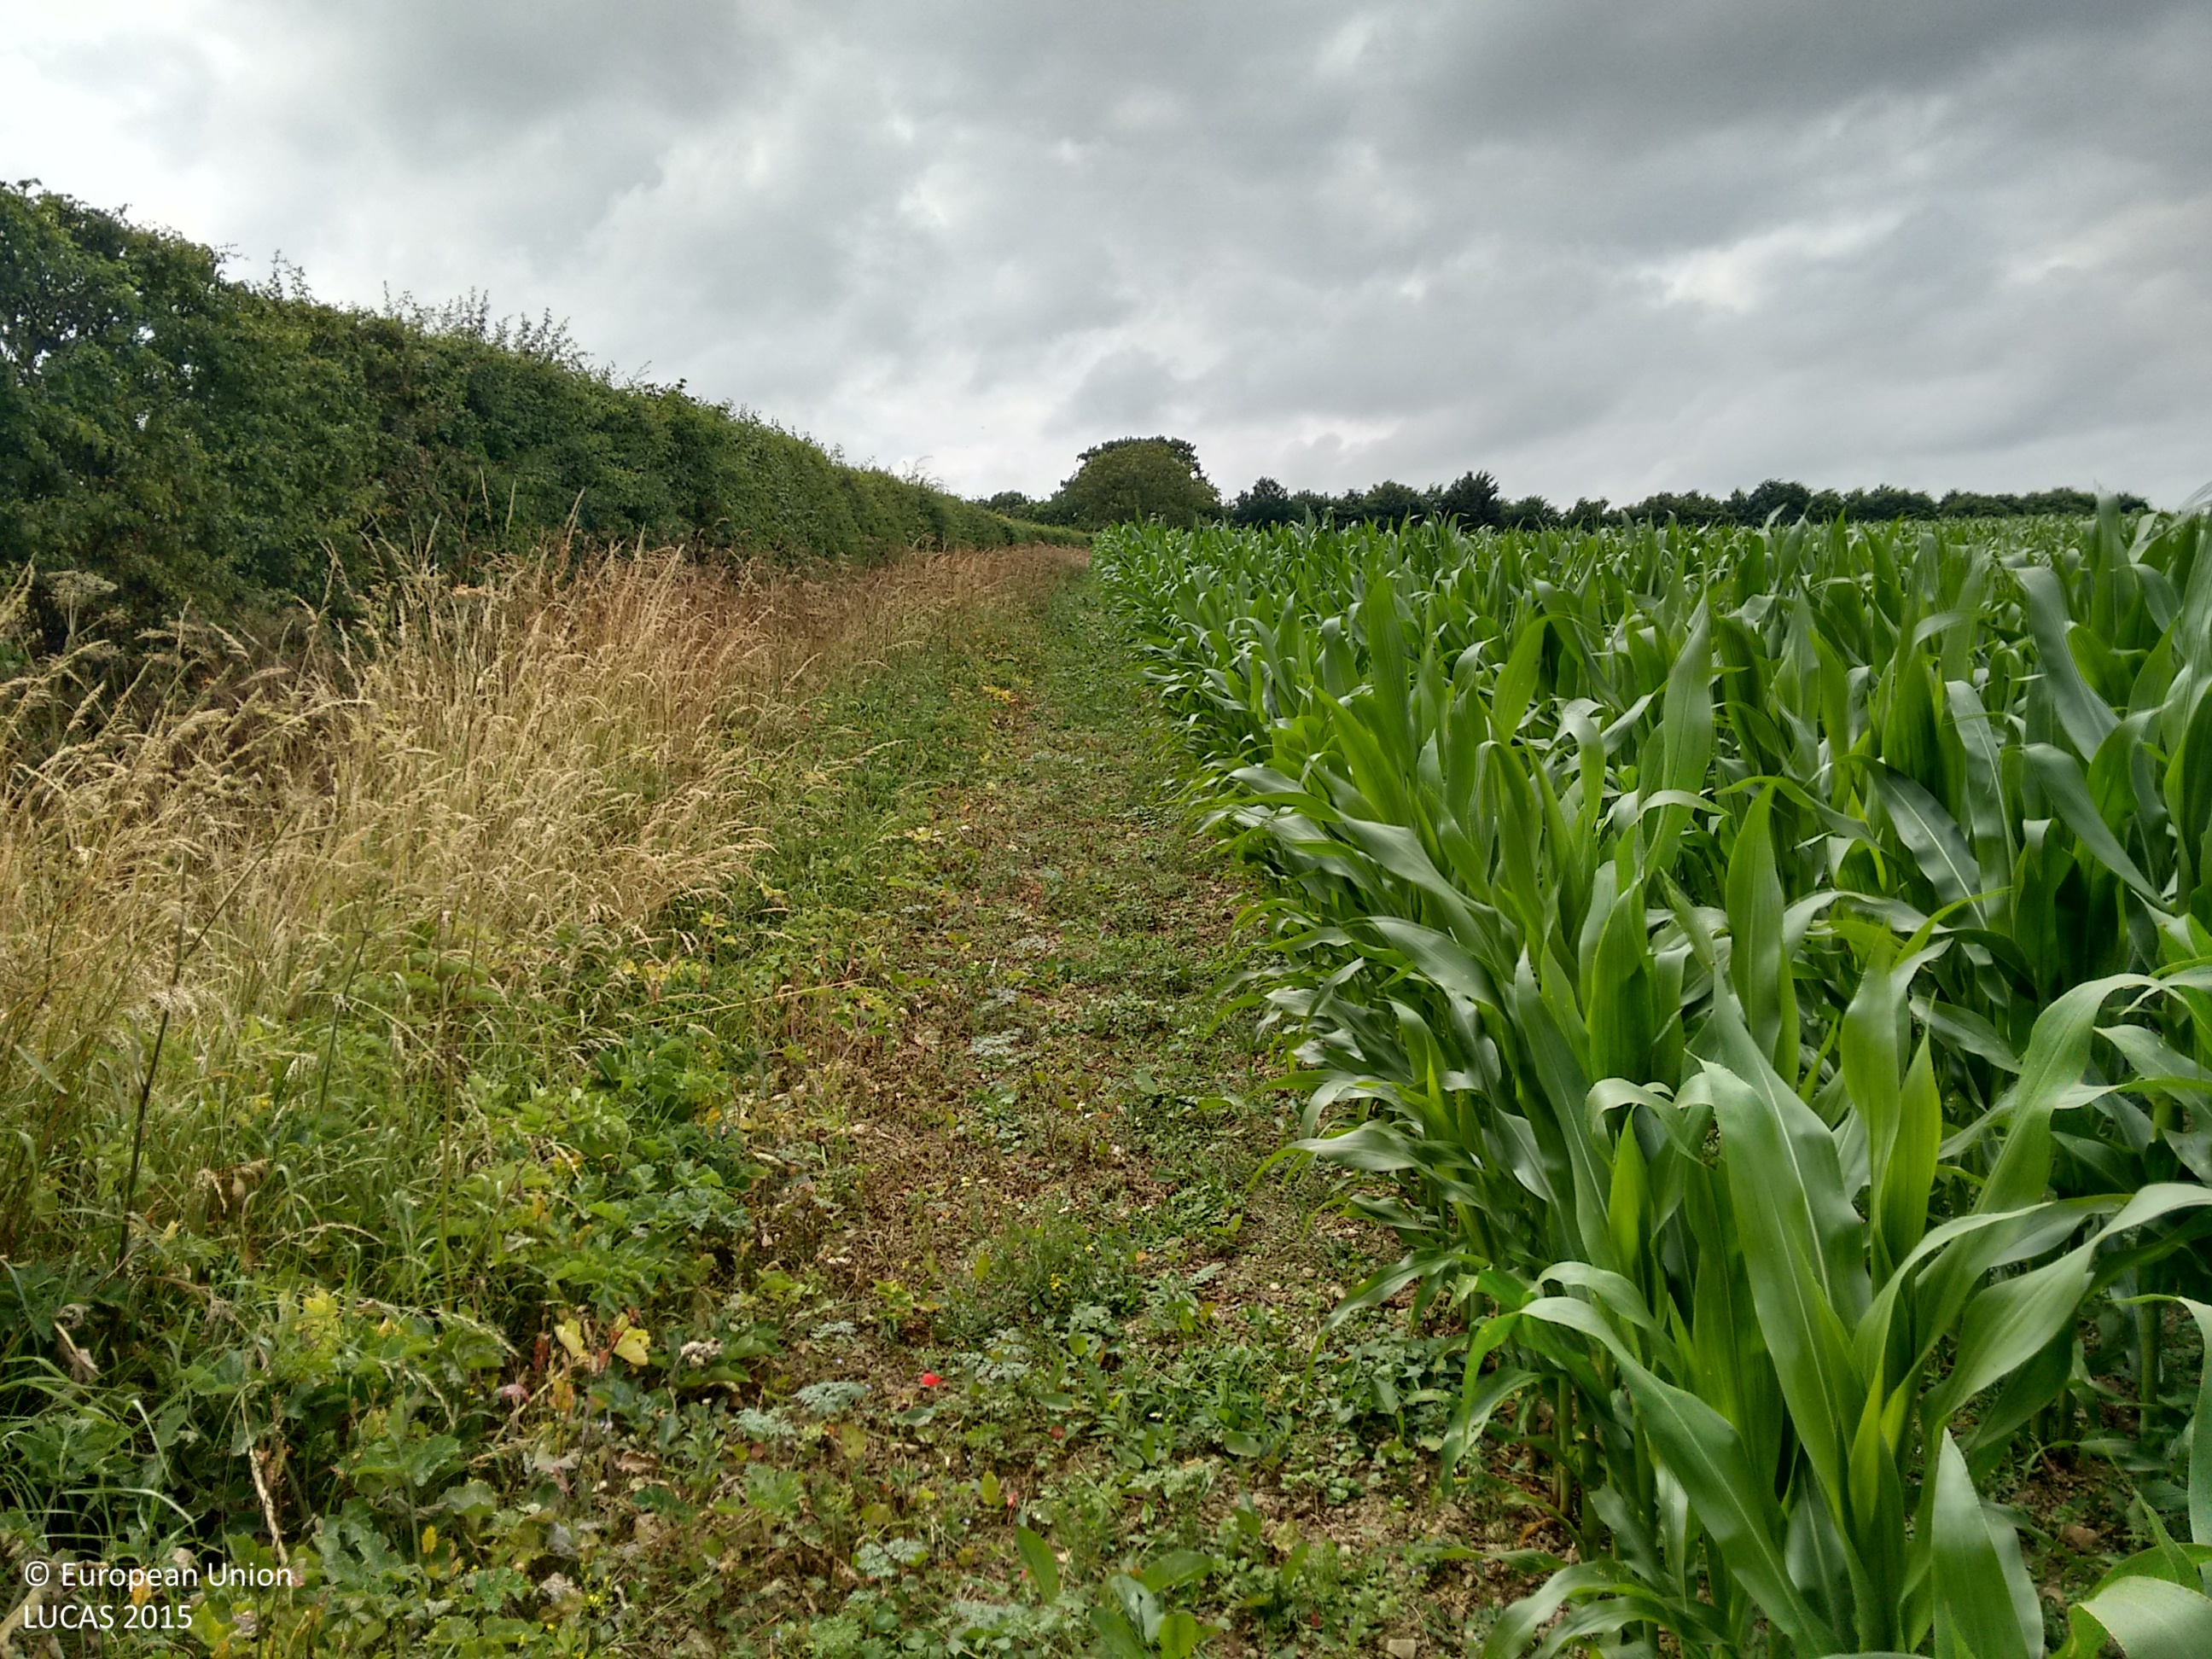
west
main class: Cropland
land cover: Maize
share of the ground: > 75 %
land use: Agriculture (excluding fallow land and kitchen gardens)
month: July
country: GB
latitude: 51.9848
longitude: -2.5163
